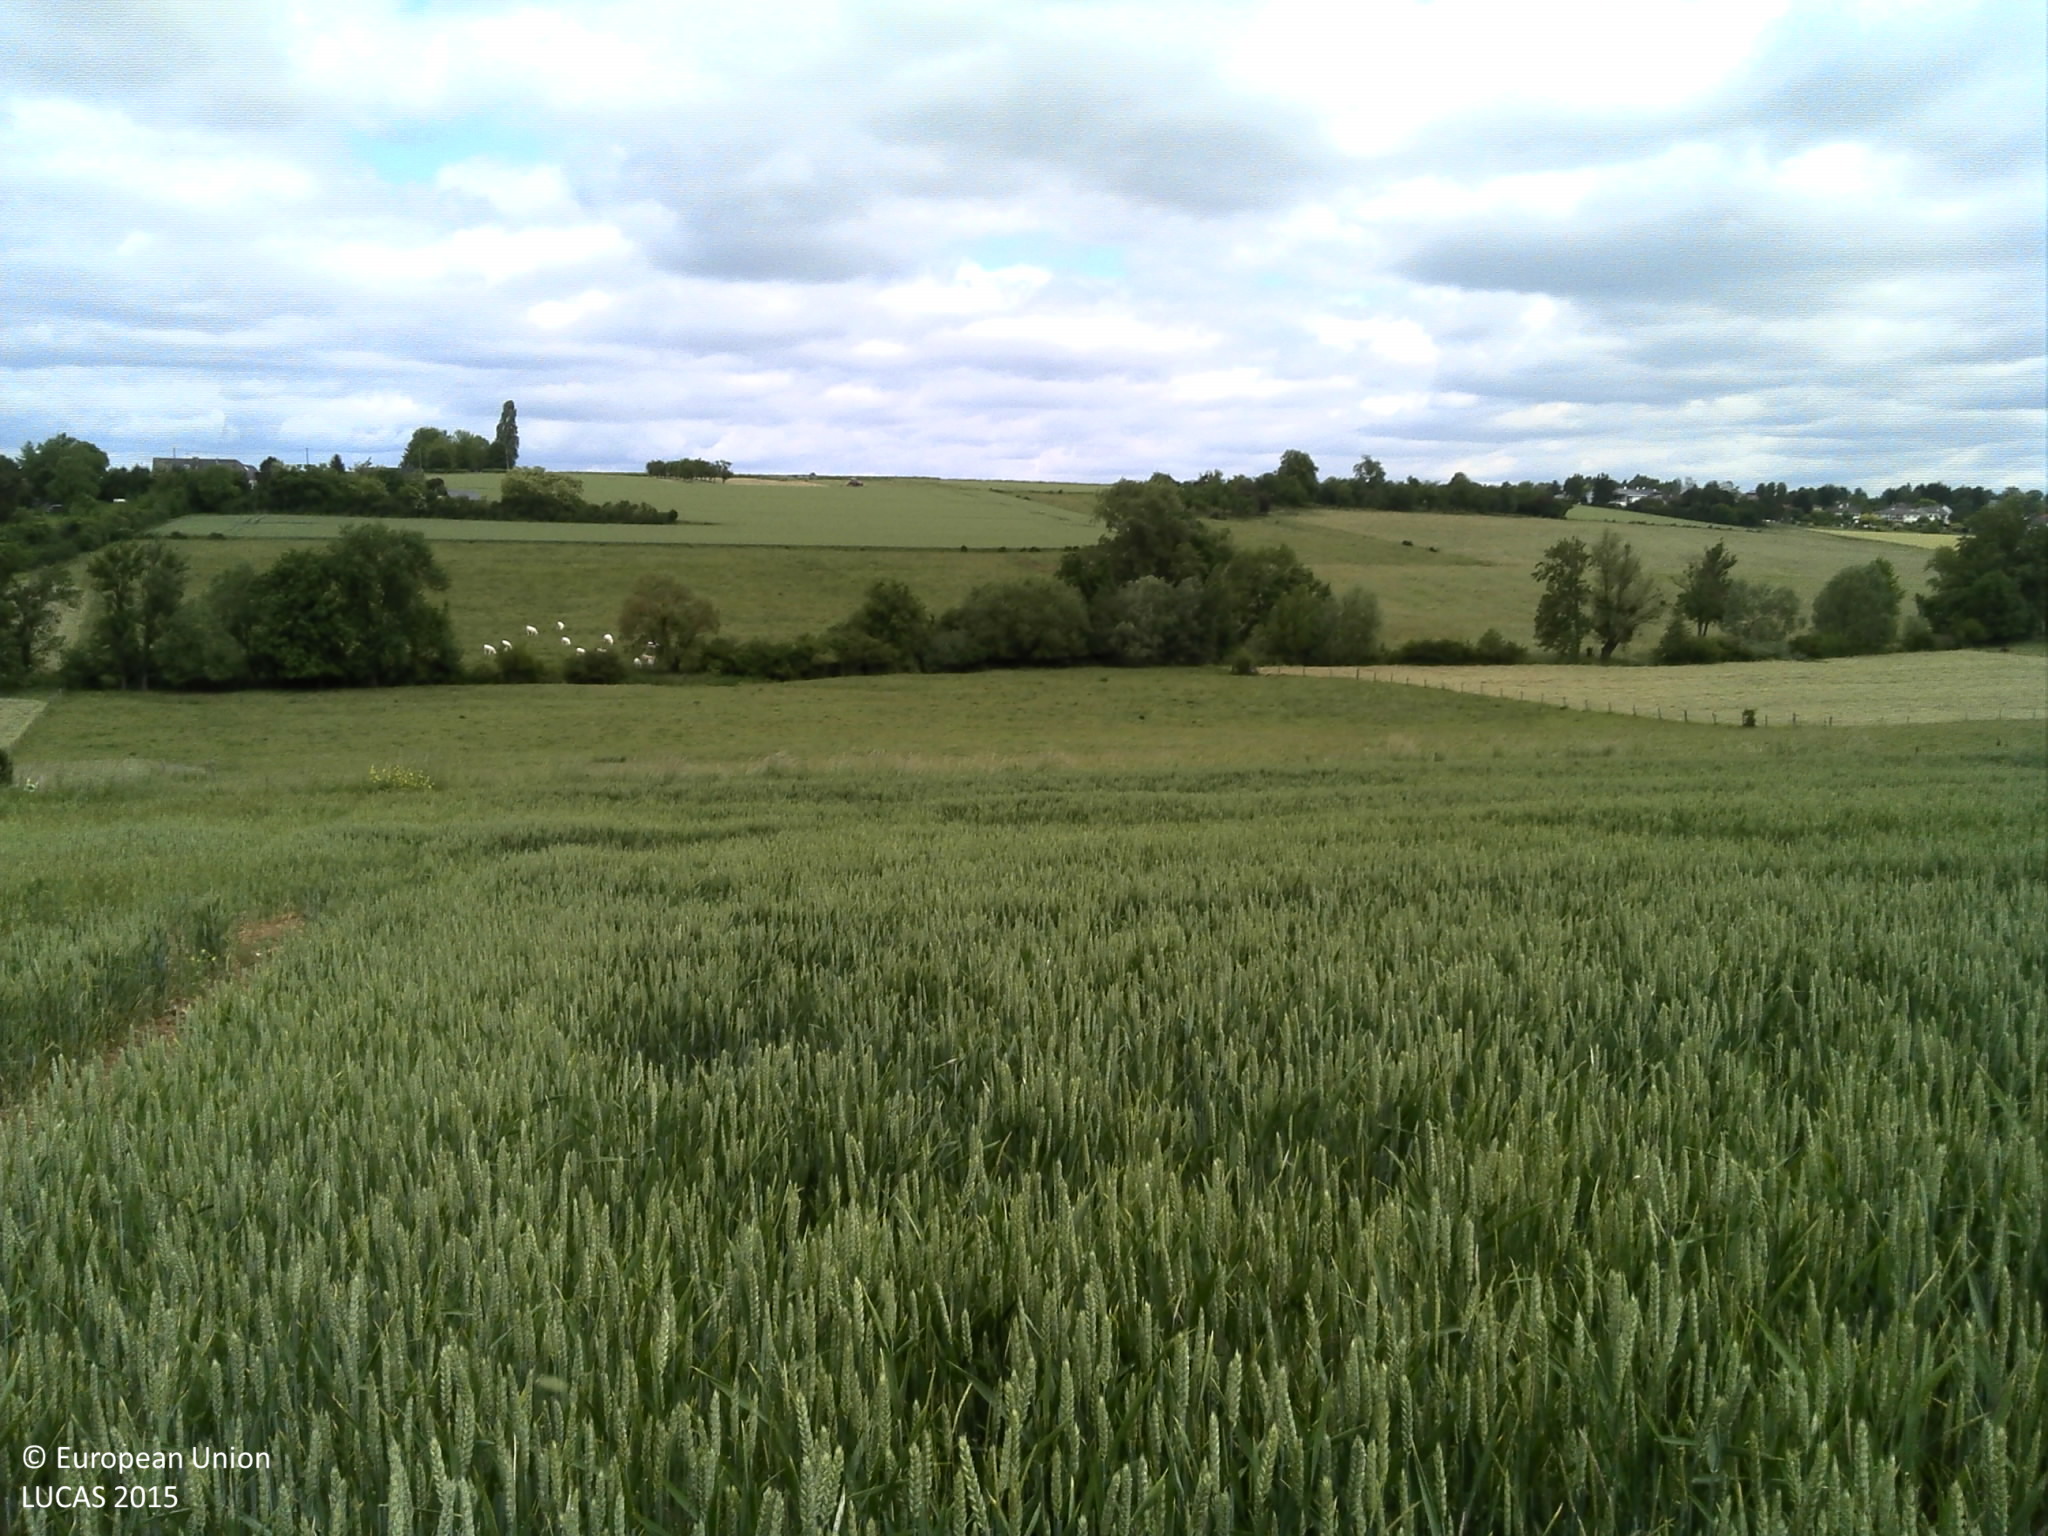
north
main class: Cropland
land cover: Common wheat
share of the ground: > 75 %
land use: Agriculture (excluding fallow land and kitchen gardens)
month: June
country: FR
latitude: 49.0051
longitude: 6.2132
